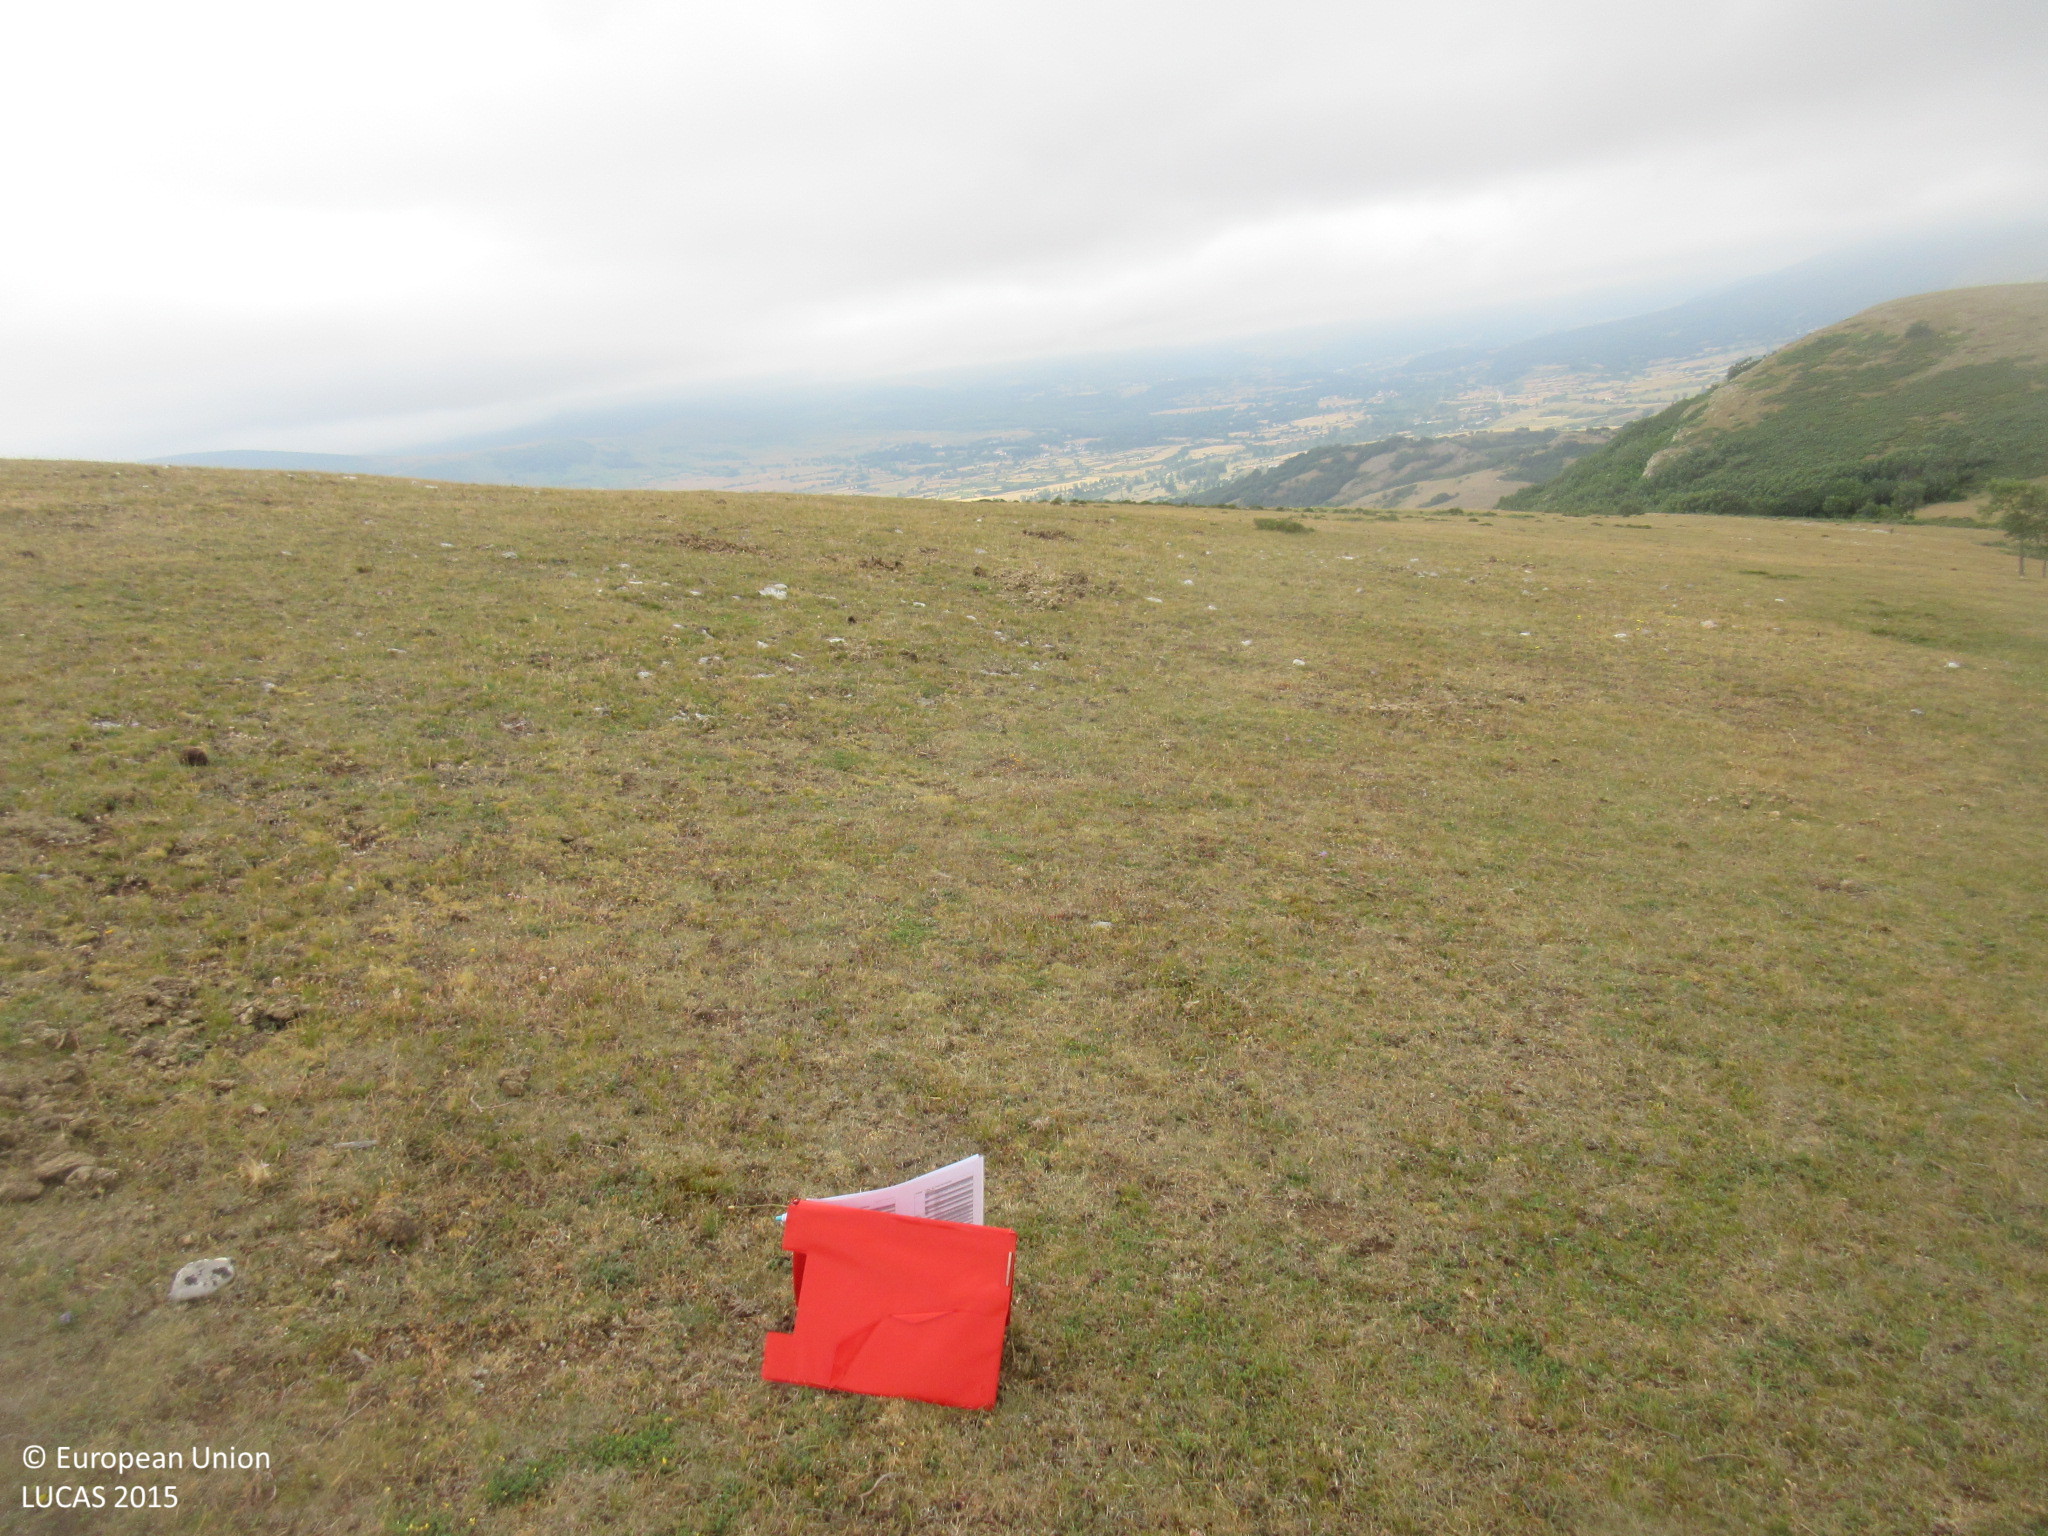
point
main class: Grassland
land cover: Grassland without tree/shrub cover
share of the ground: > 75 %
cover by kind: herbaceous plants 95 %, shrubs 5 %
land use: Agriculture (excluding fallow land and kitchen gardens)
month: July
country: ES
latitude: 43.0241
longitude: -4.1755
